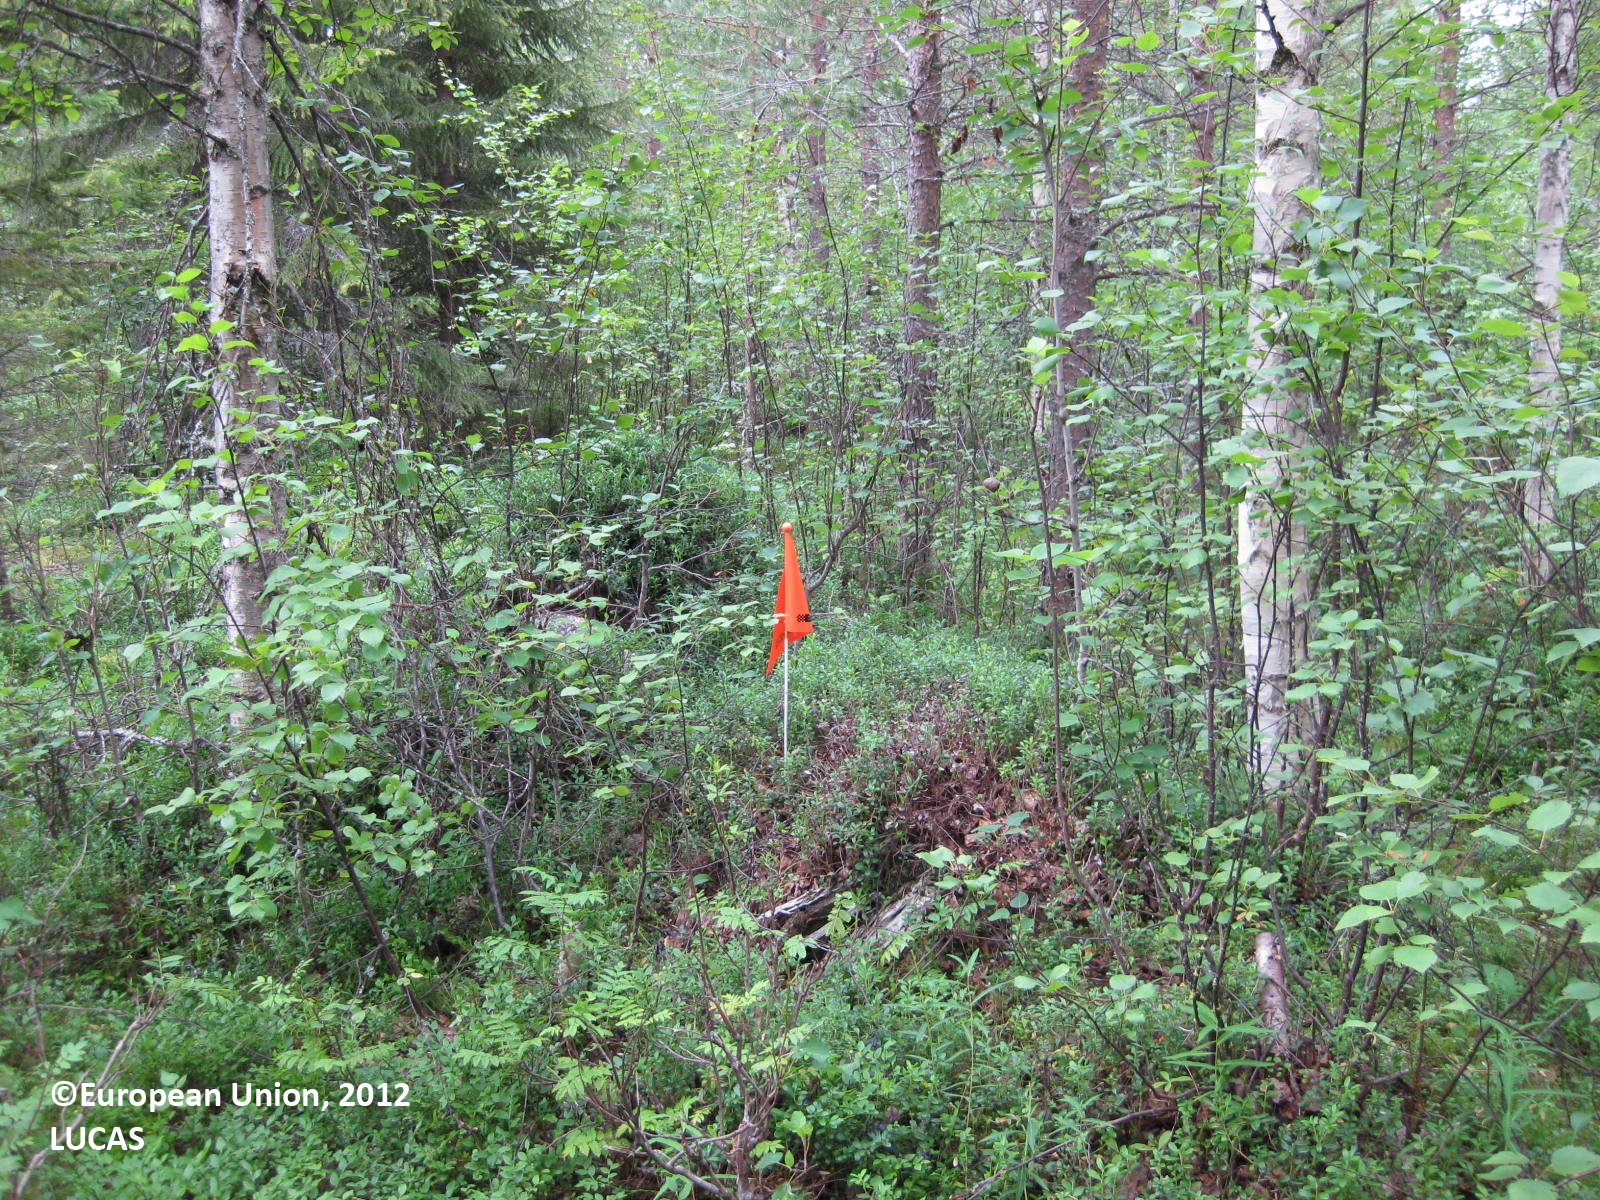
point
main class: Woodland
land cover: Pine dominated mixed woodland
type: boreal forest
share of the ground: > 75 %
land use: Forestry
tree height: > 5 m
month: July
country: FI
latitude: 65.7900
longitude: 28.5827
